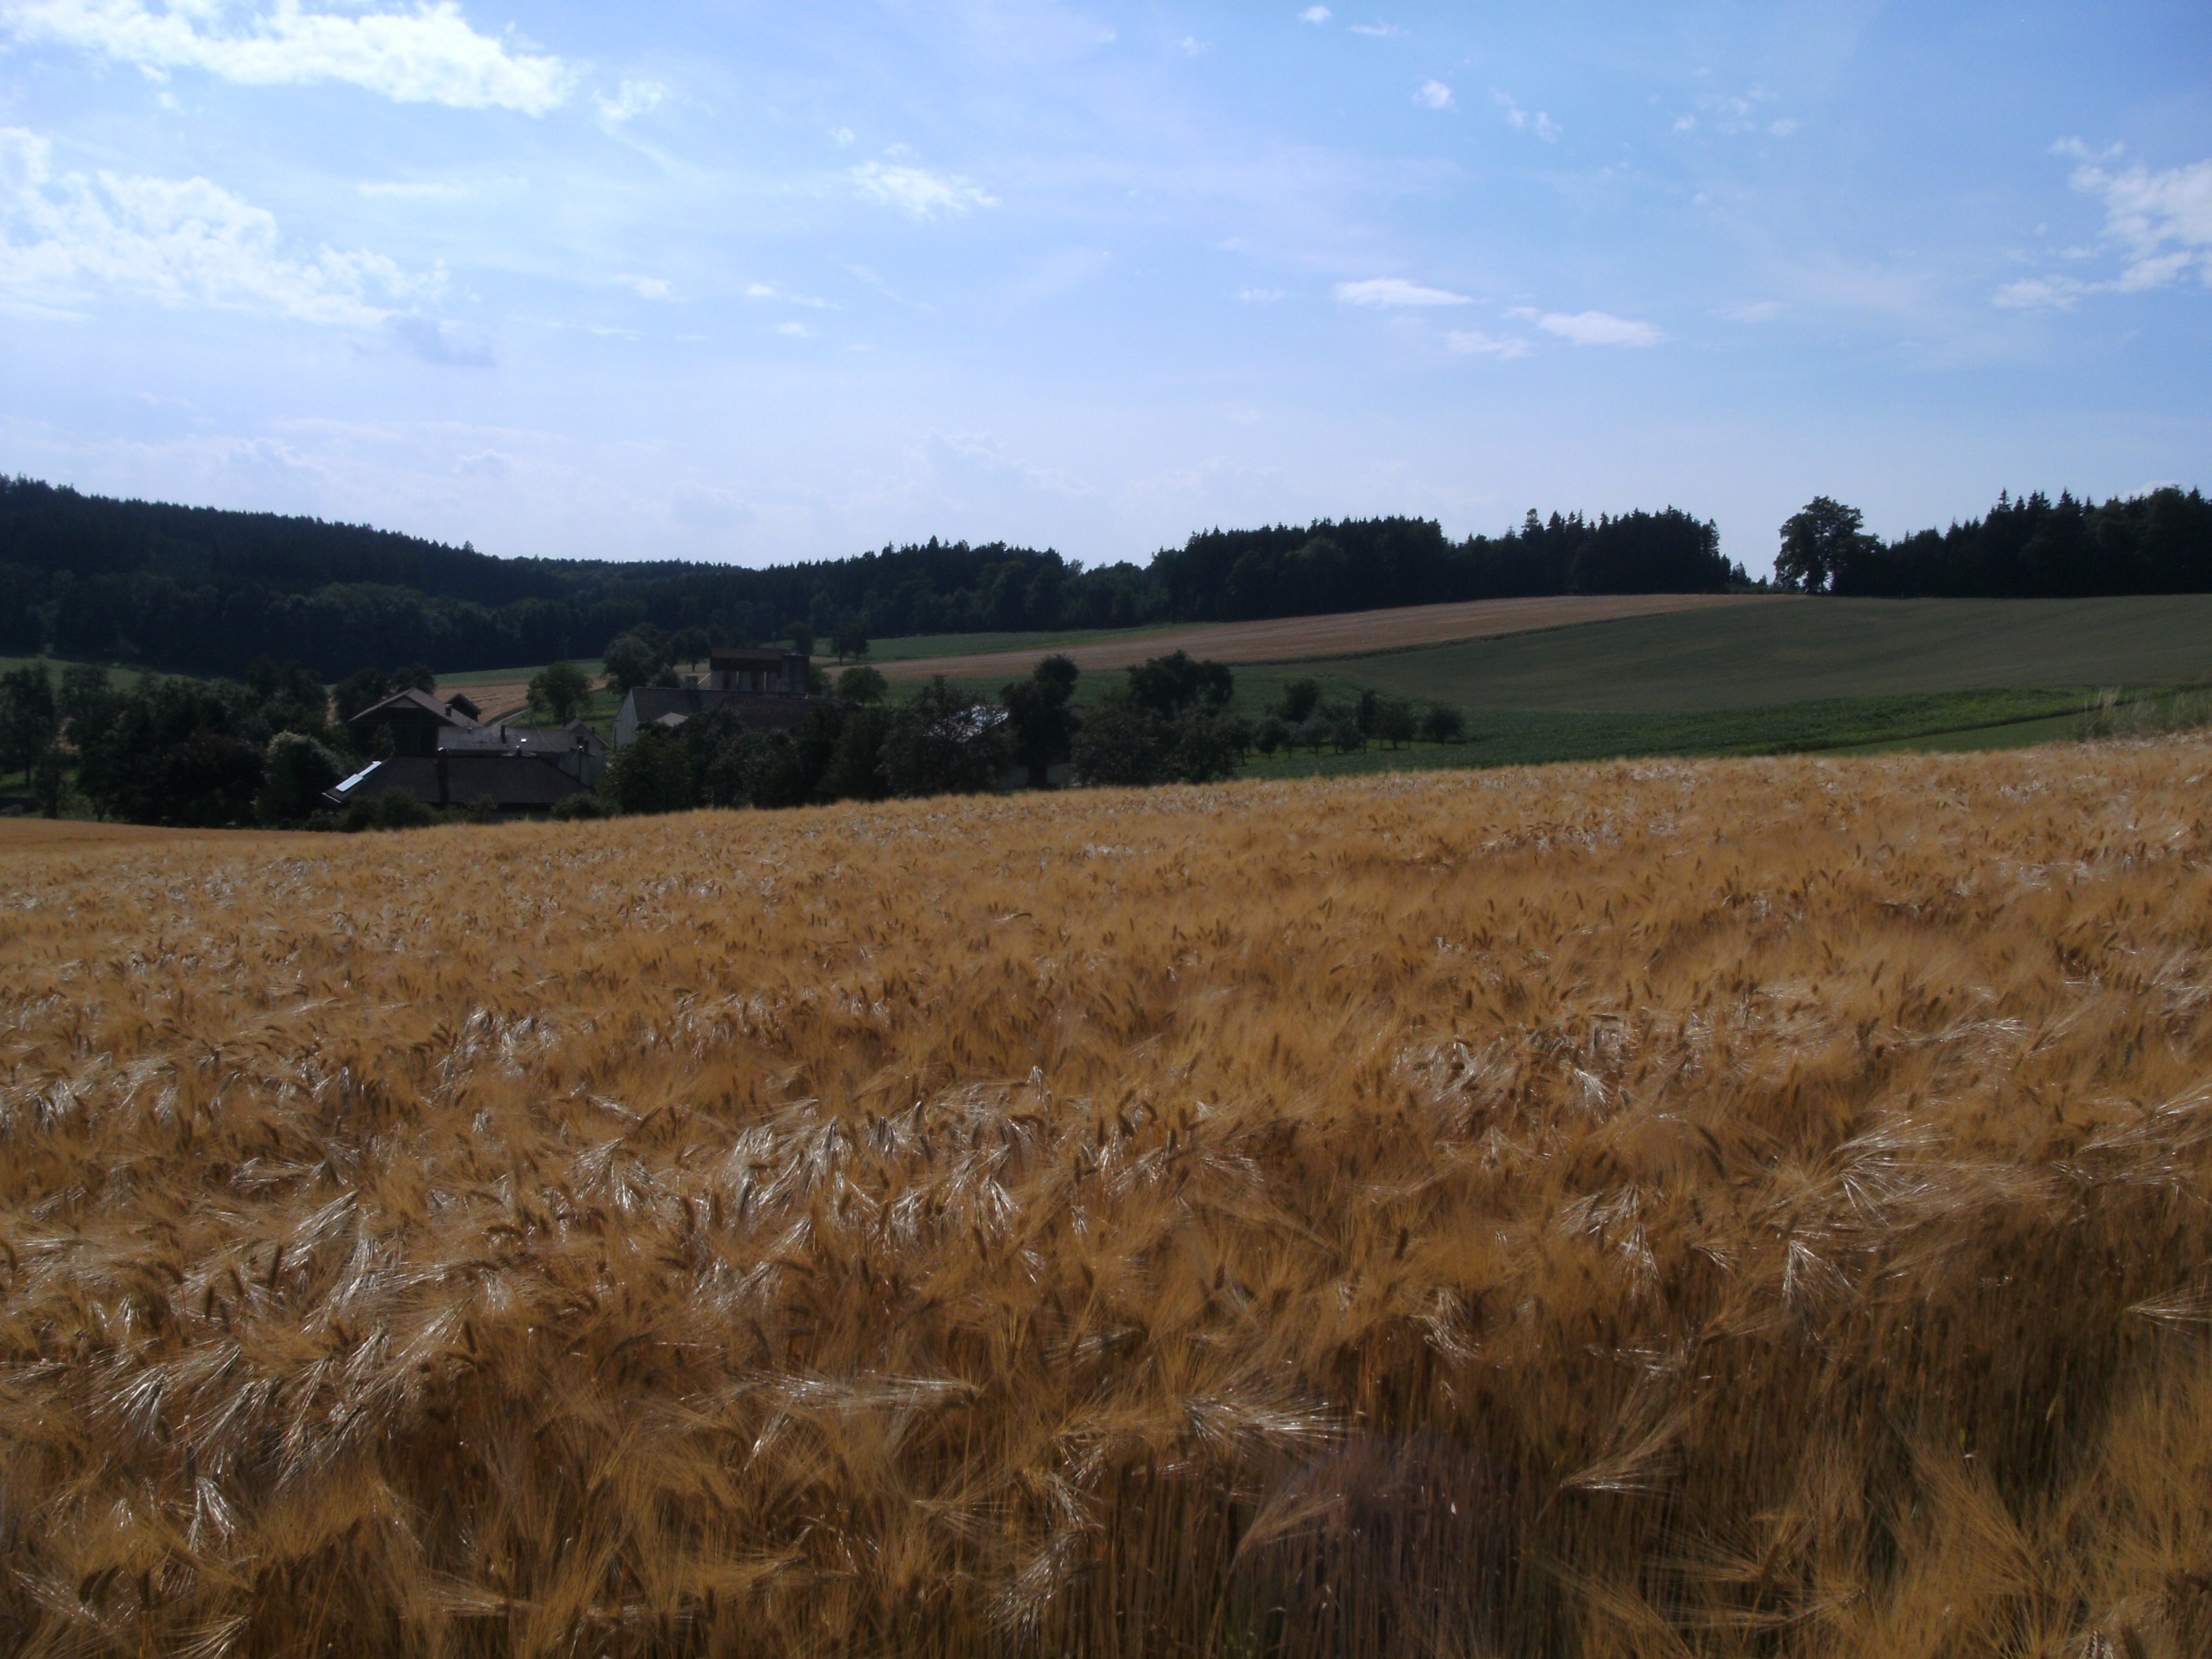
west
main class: Cropland
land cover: Barley
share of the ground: > 75 %
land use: Agriculture (excluding fallow land and kitchen gardens)
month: June
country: AT
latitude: 48.2505
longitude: 13.7301
